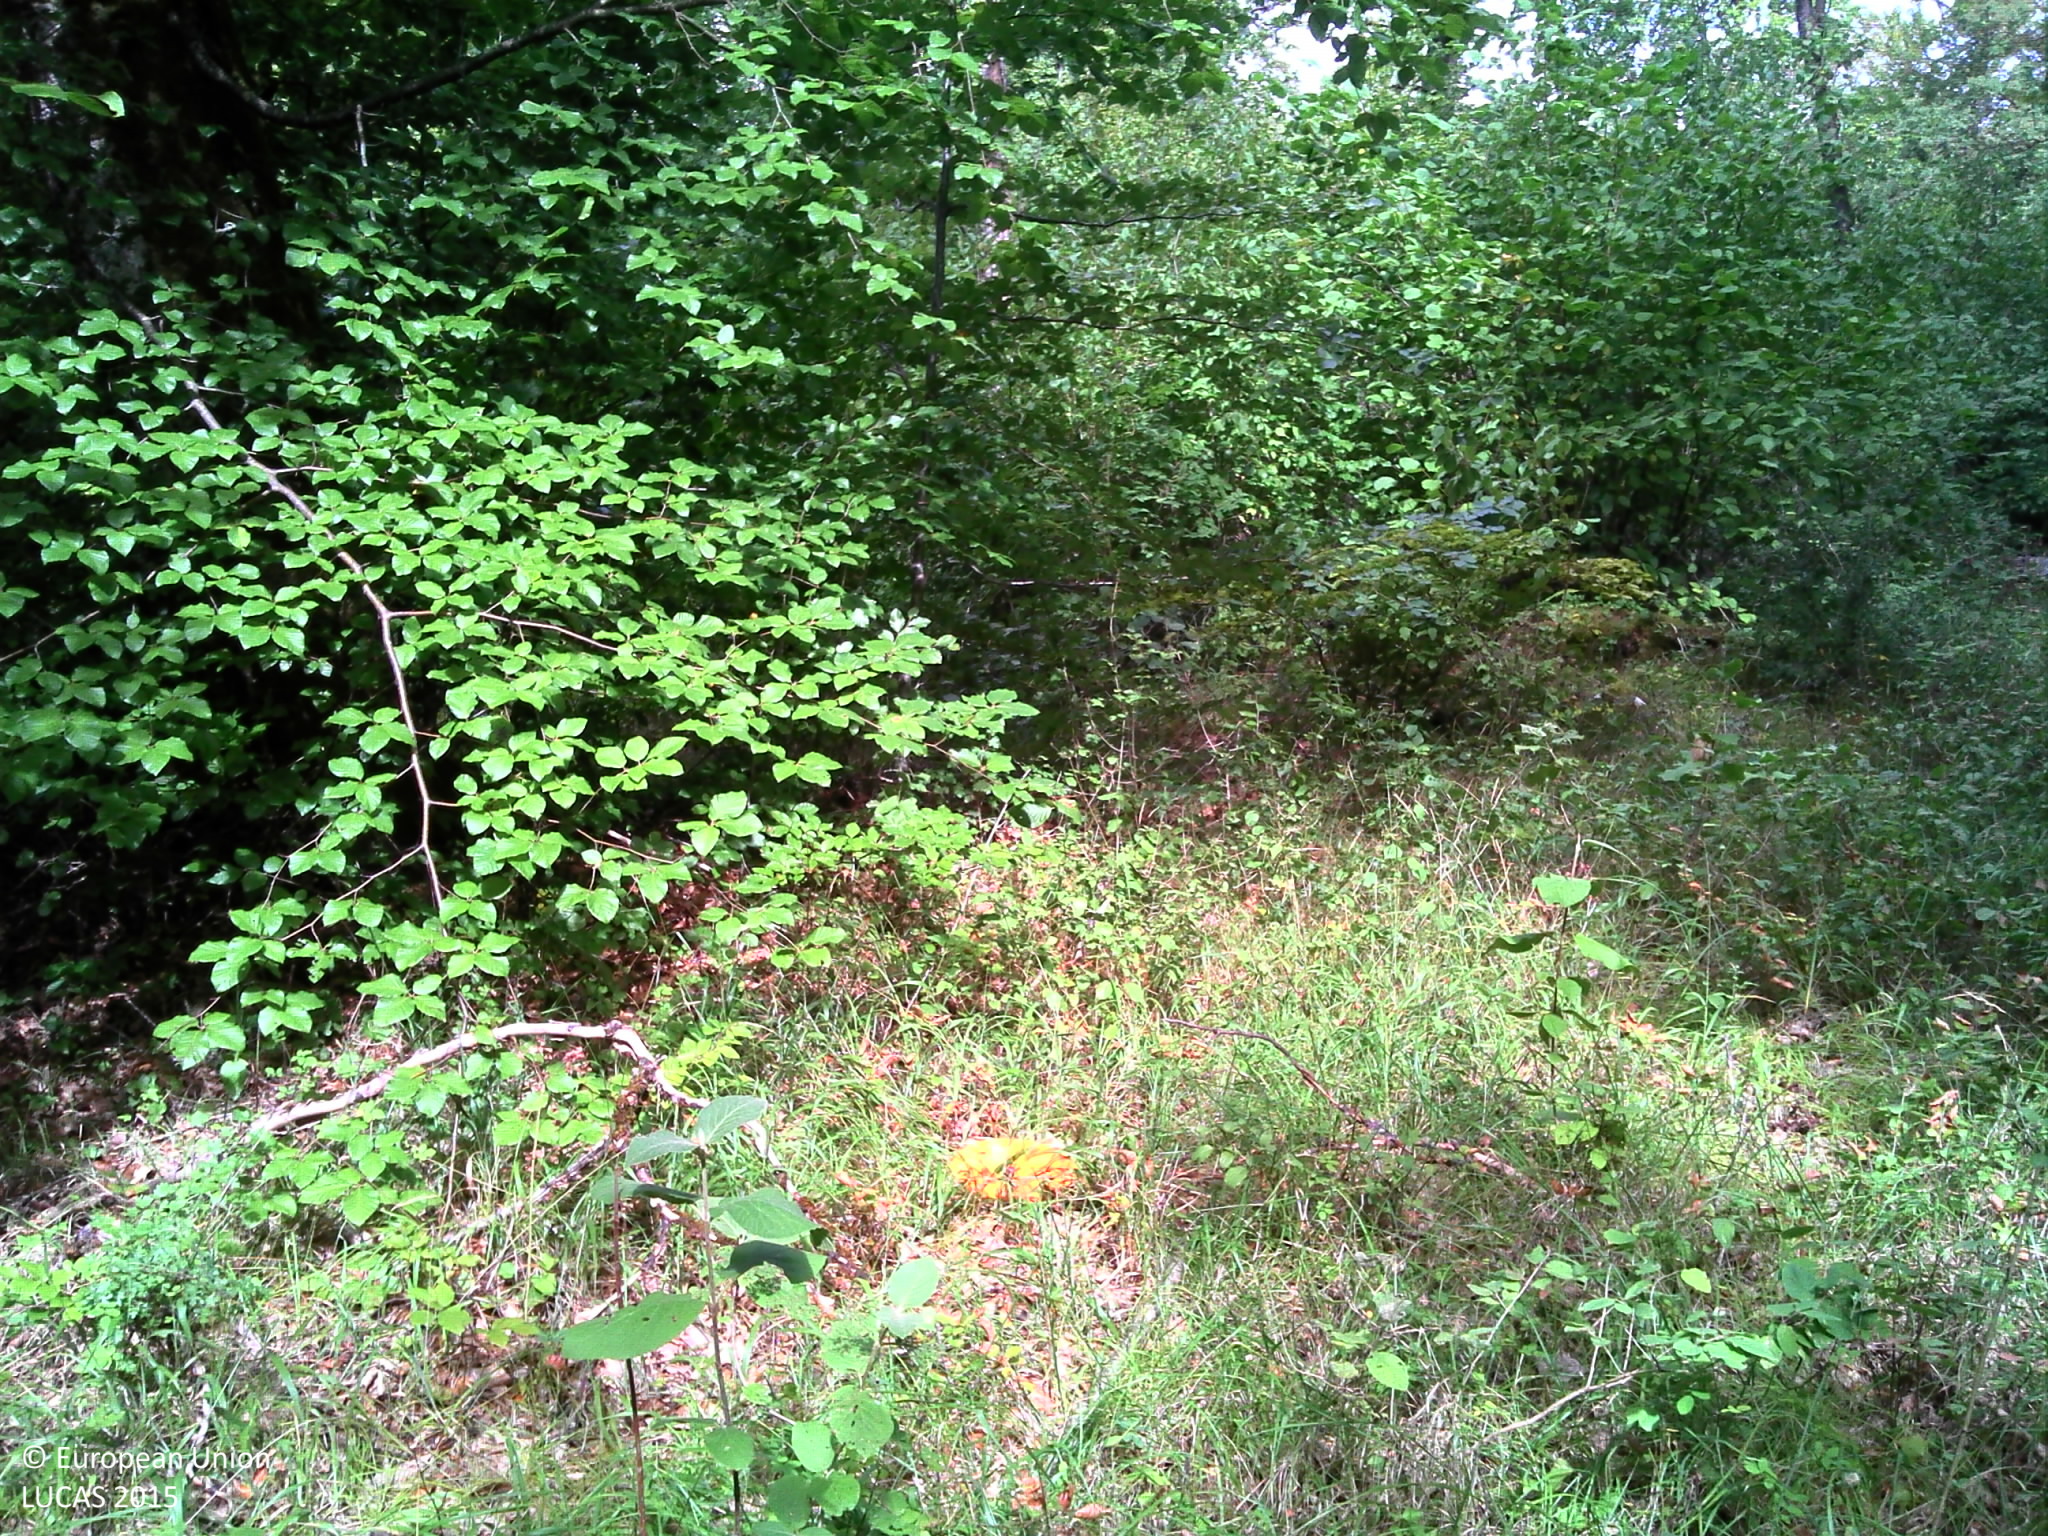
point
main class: Woodland
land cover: Broadleaved woodland
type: mesophytic deciduous forest
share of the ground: > 75 %
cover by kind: broadleaved forest trees 85 %, herbaceous plants 10 %, lichens and mosses 5 %
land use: Forestry
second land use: Amenities, museums, leisure
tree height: > 5 m
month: August
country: FR
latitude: 47.7111
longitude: 4.9481
